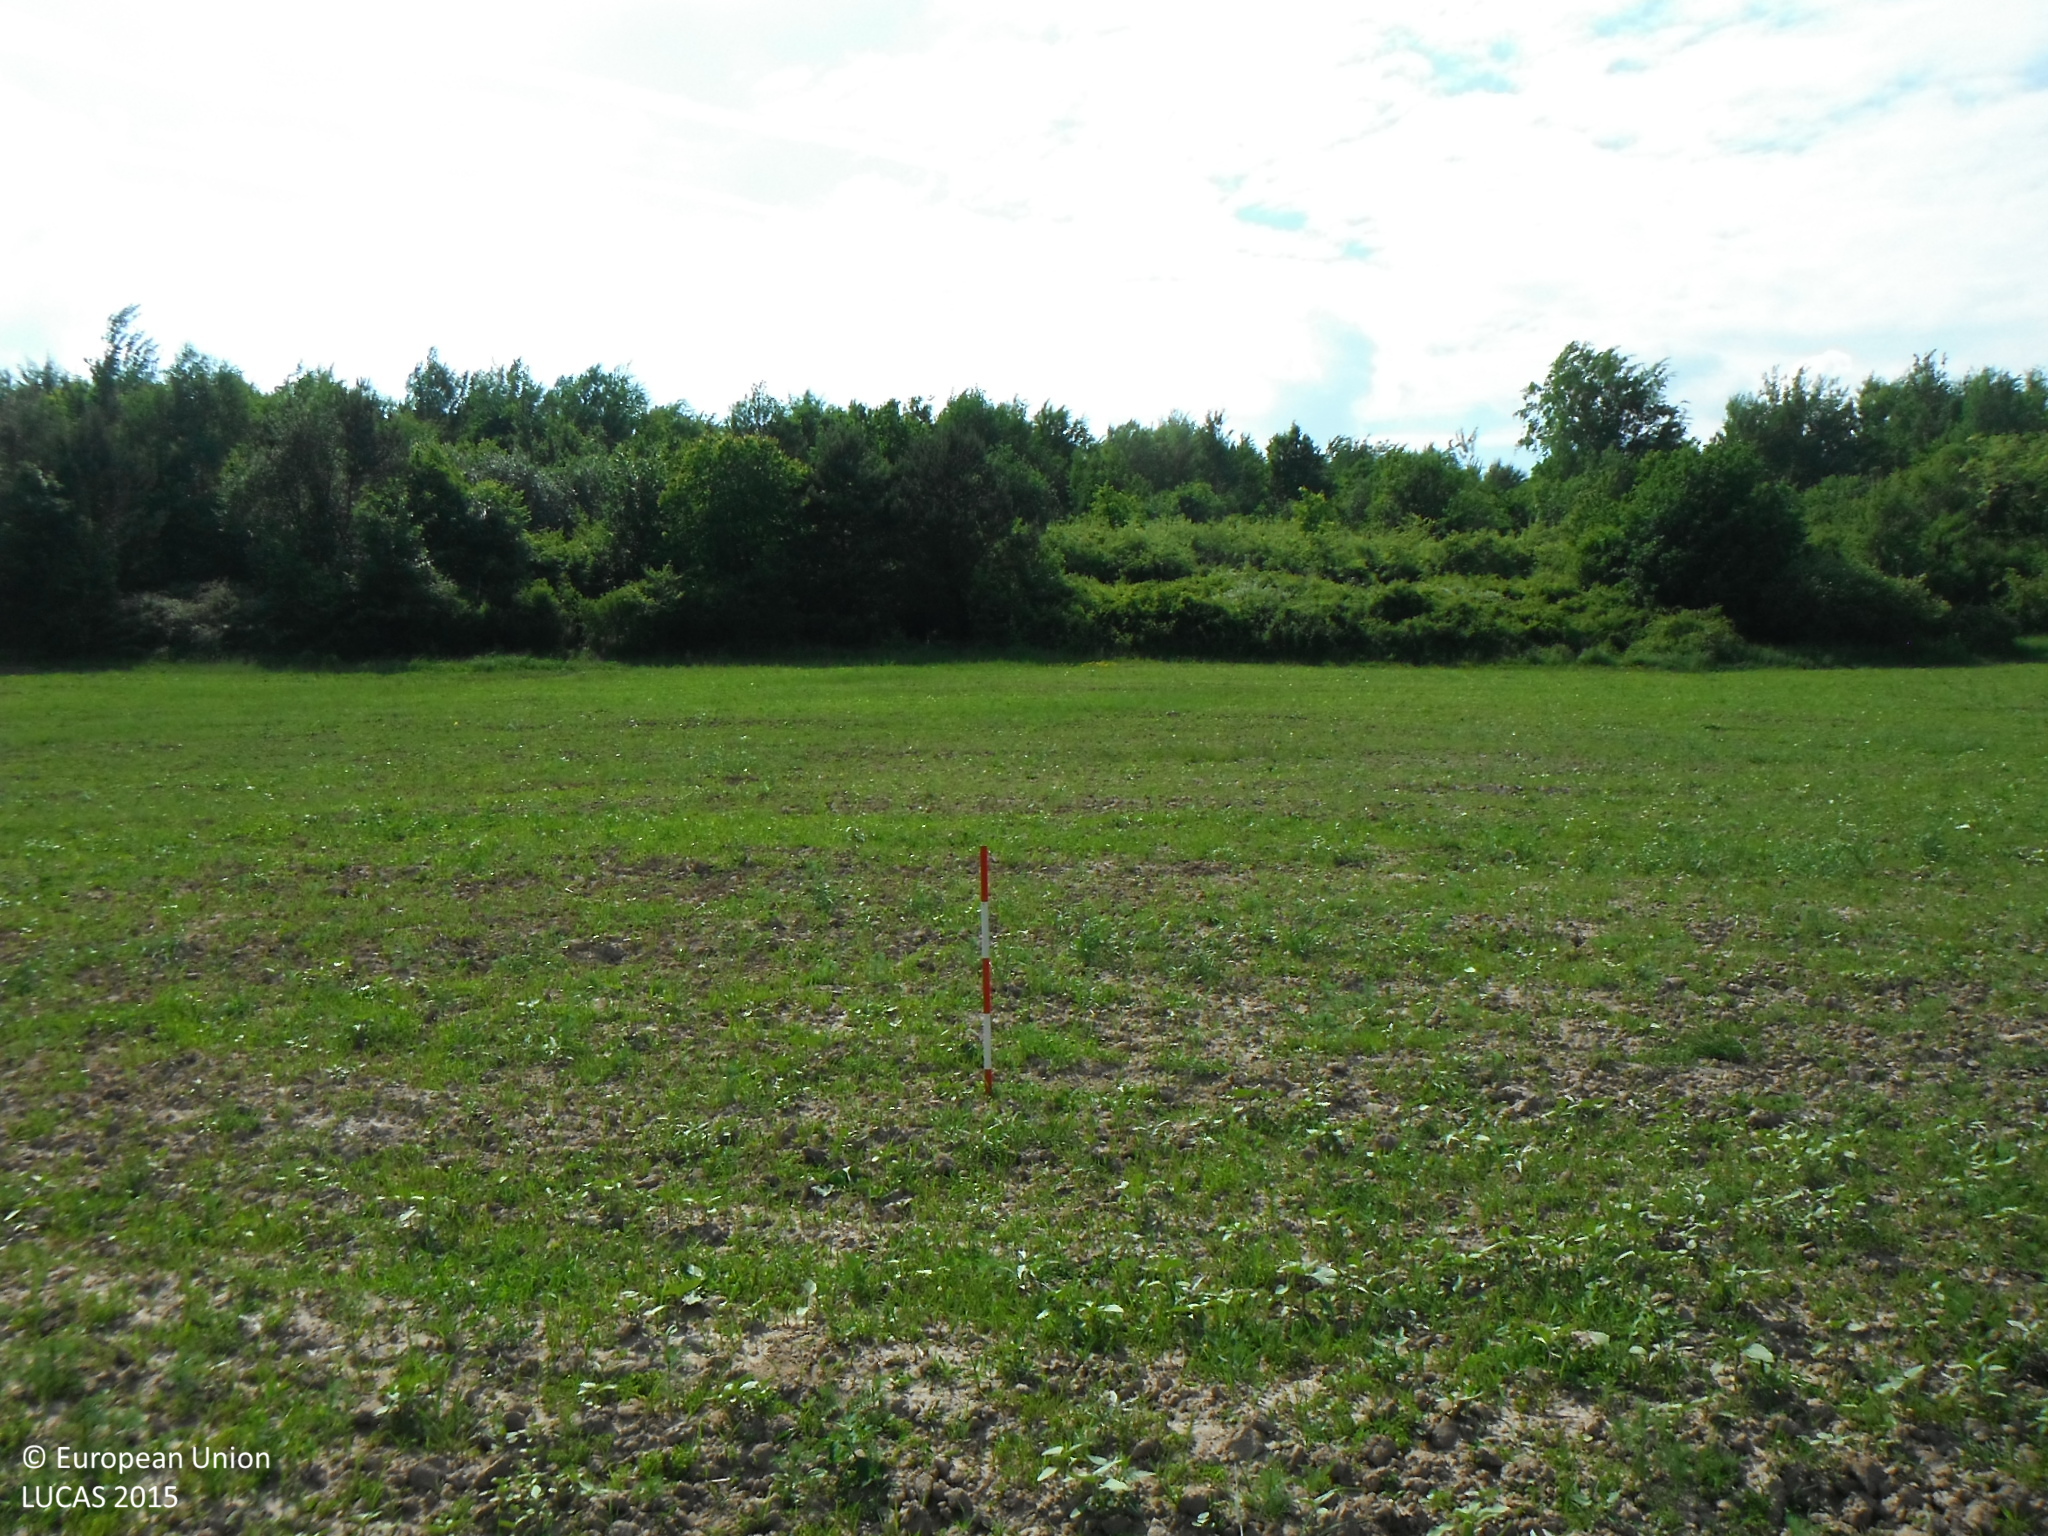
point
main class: Cropland
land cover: Sunflower
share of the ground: 10 - 25 %
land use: Agriculture (excluding fallow land and kitchen gardens)
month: June
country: SK
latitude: 48.8818
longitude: 21.7656
